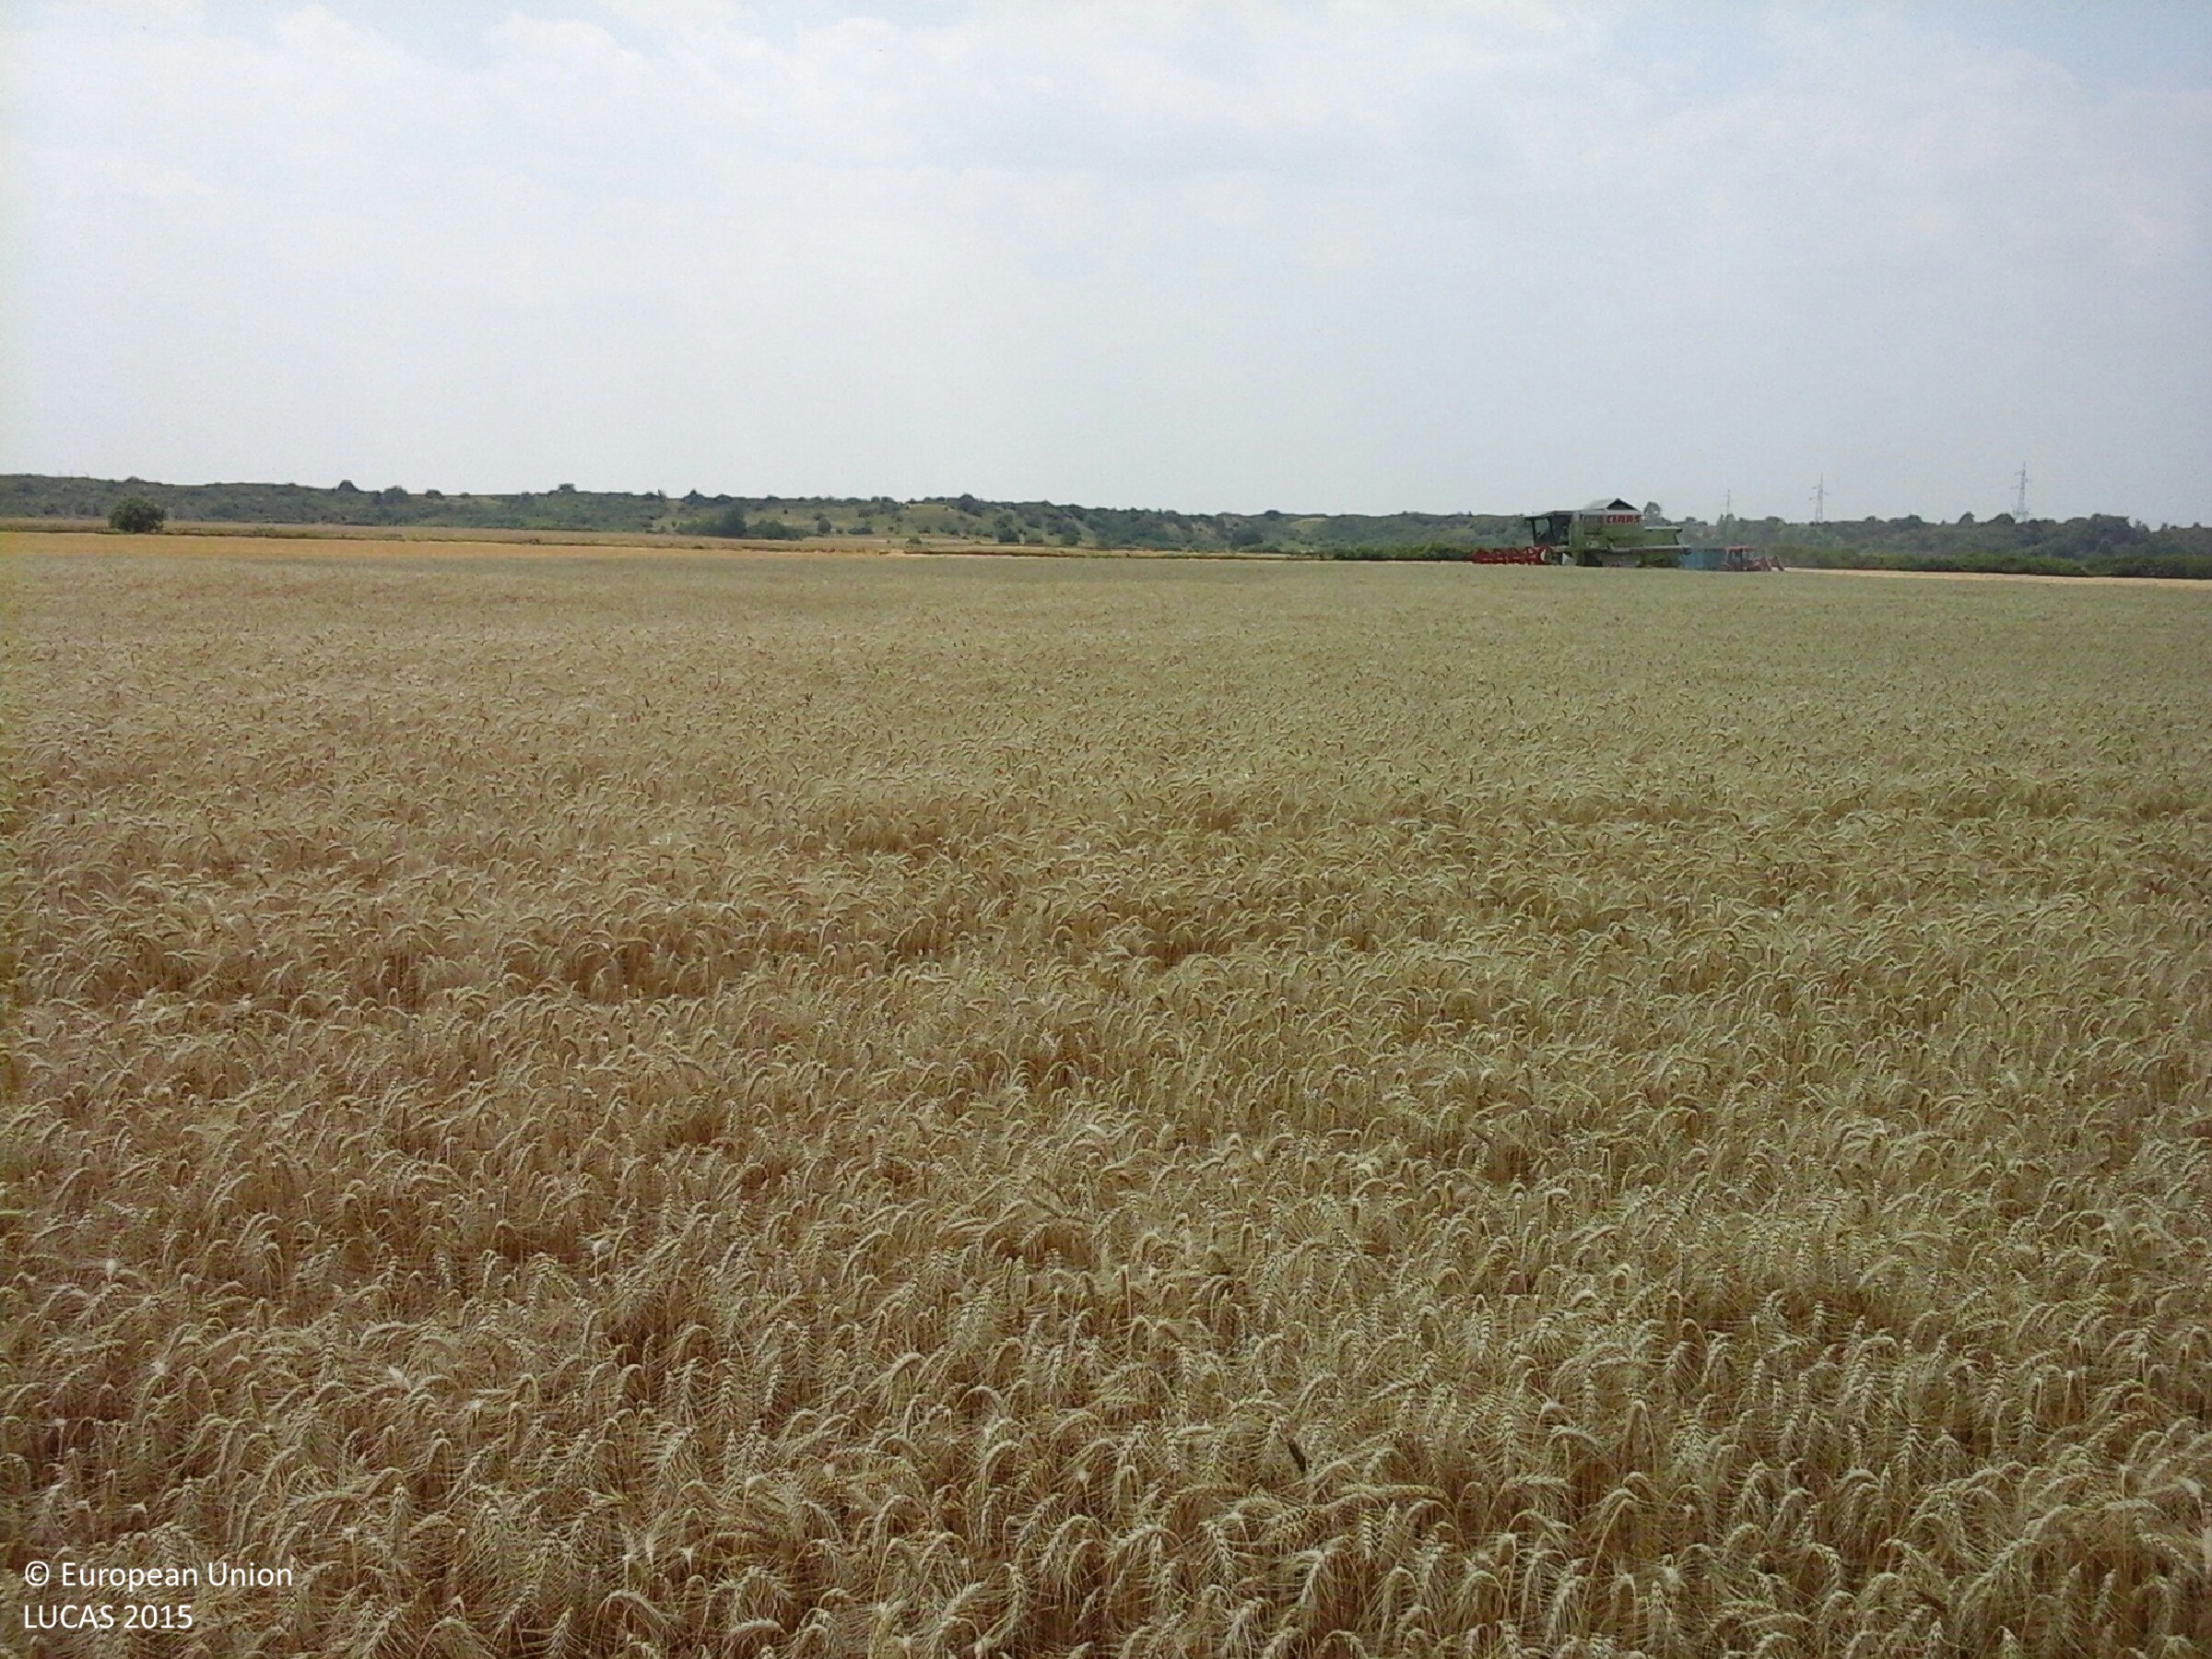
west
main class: Cropland
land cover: Common wheat
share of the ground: > 75 %
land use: Agriculture (excluding fallow land and kitchen gardens)
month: July
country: HU
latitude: 47.7718
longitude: 20.3455
